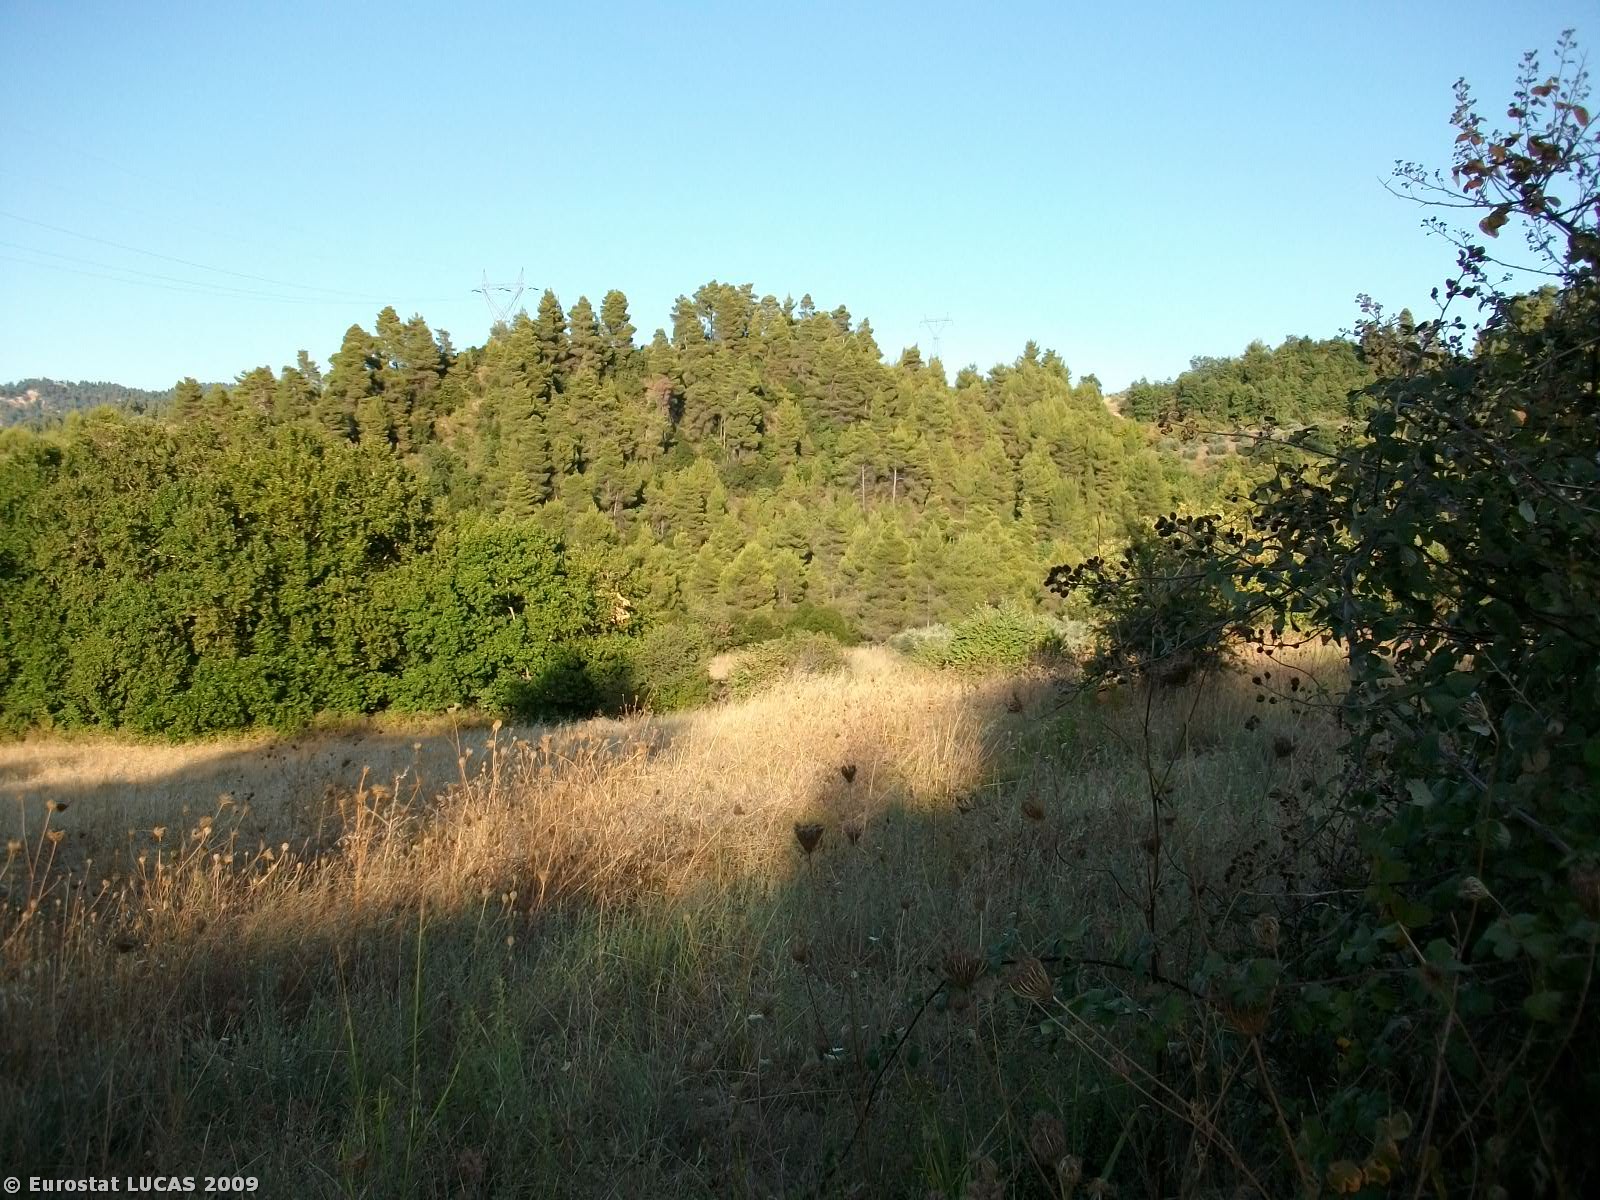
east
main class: Grassland
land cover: Grassland without tree/shrub cover
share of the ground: > 75 %
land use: Unused
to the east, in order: Grassland without tree/shrub cover; Shrubland with sparse tree cover; Grassland without tree/shrub cover; Mixed woodland; Tracks; Mixed woodland; Rivers and streams; Mixed woodland
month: August
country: GR
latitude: 38.9143
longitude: 23.1931
